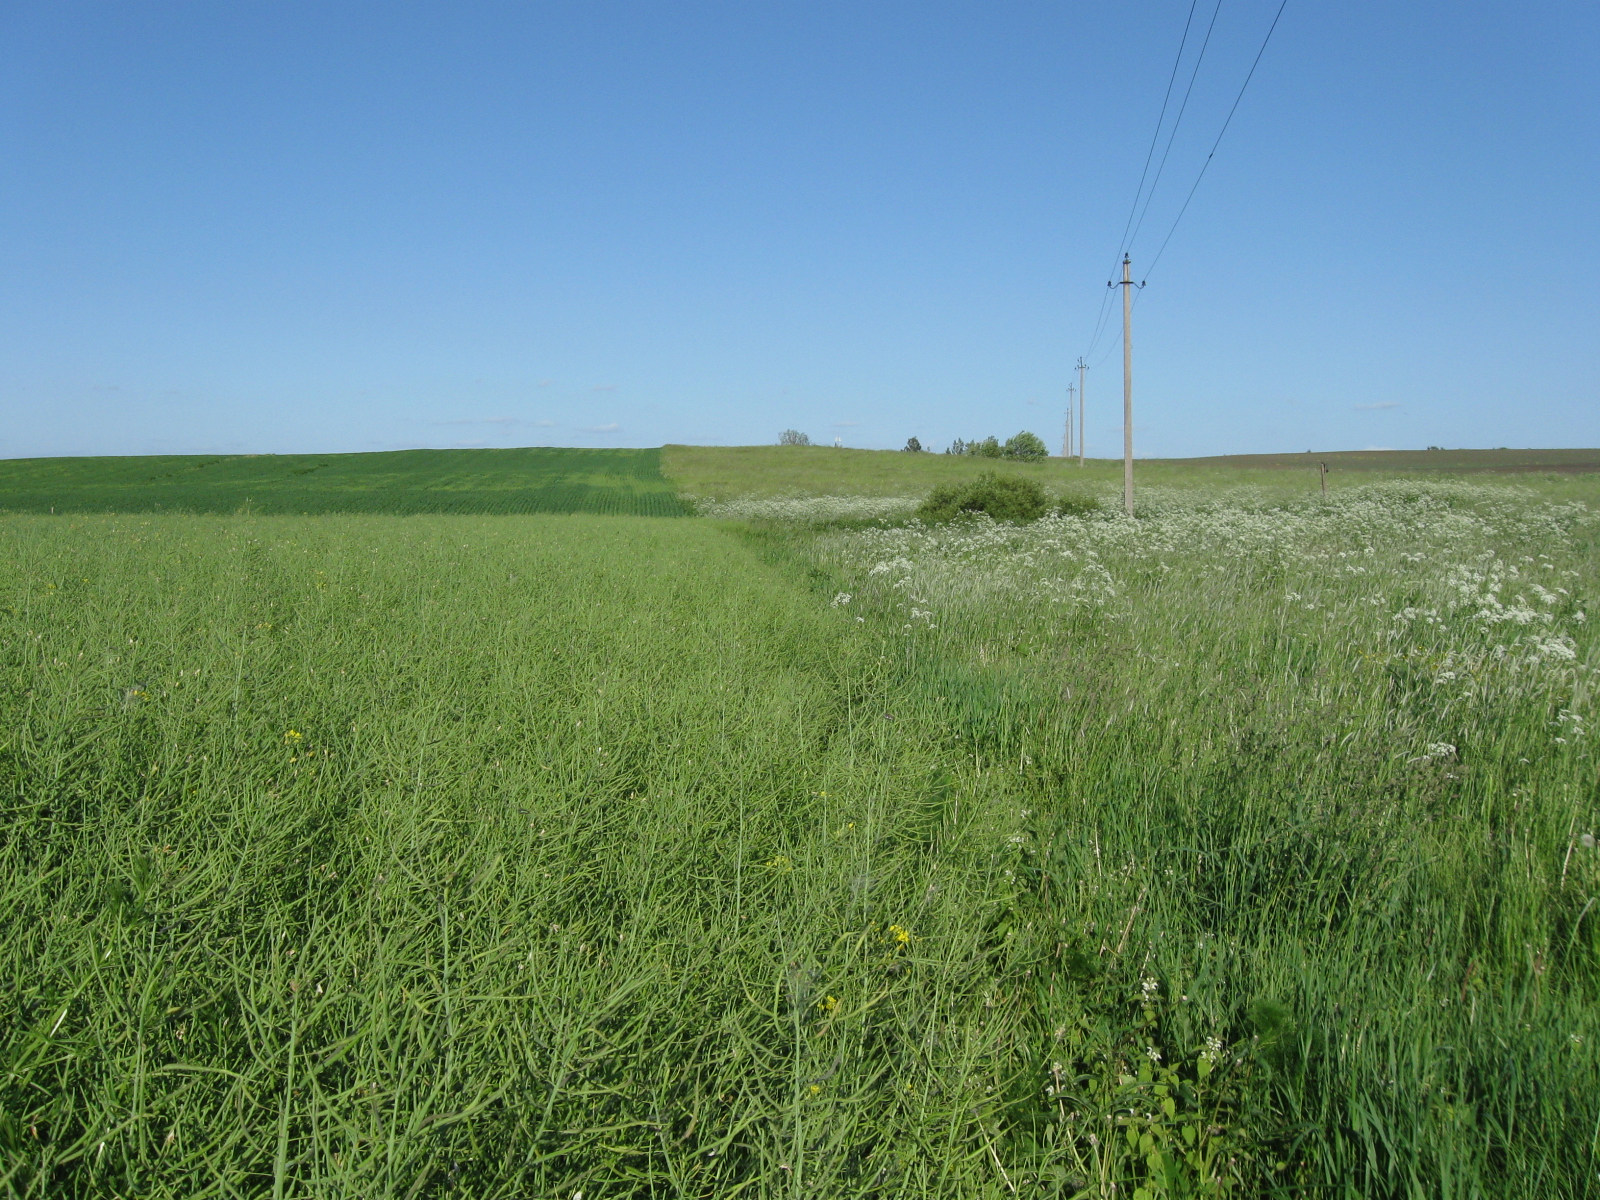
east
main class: Cropland
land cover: Rape and turnip rape
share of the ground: > 75 %
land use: Agriculture (excluding fallow land and kitchen gardens)
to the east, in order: Rape and turnip rape; Grass margins; Ditches and canals; Grass margins; Tracks; Mixed cereals for fodder; Grassland without tree/shrub cover; Paved roads, cycling and walking lanes
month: June
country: LT
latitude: 54.4333
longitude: 23.7930
